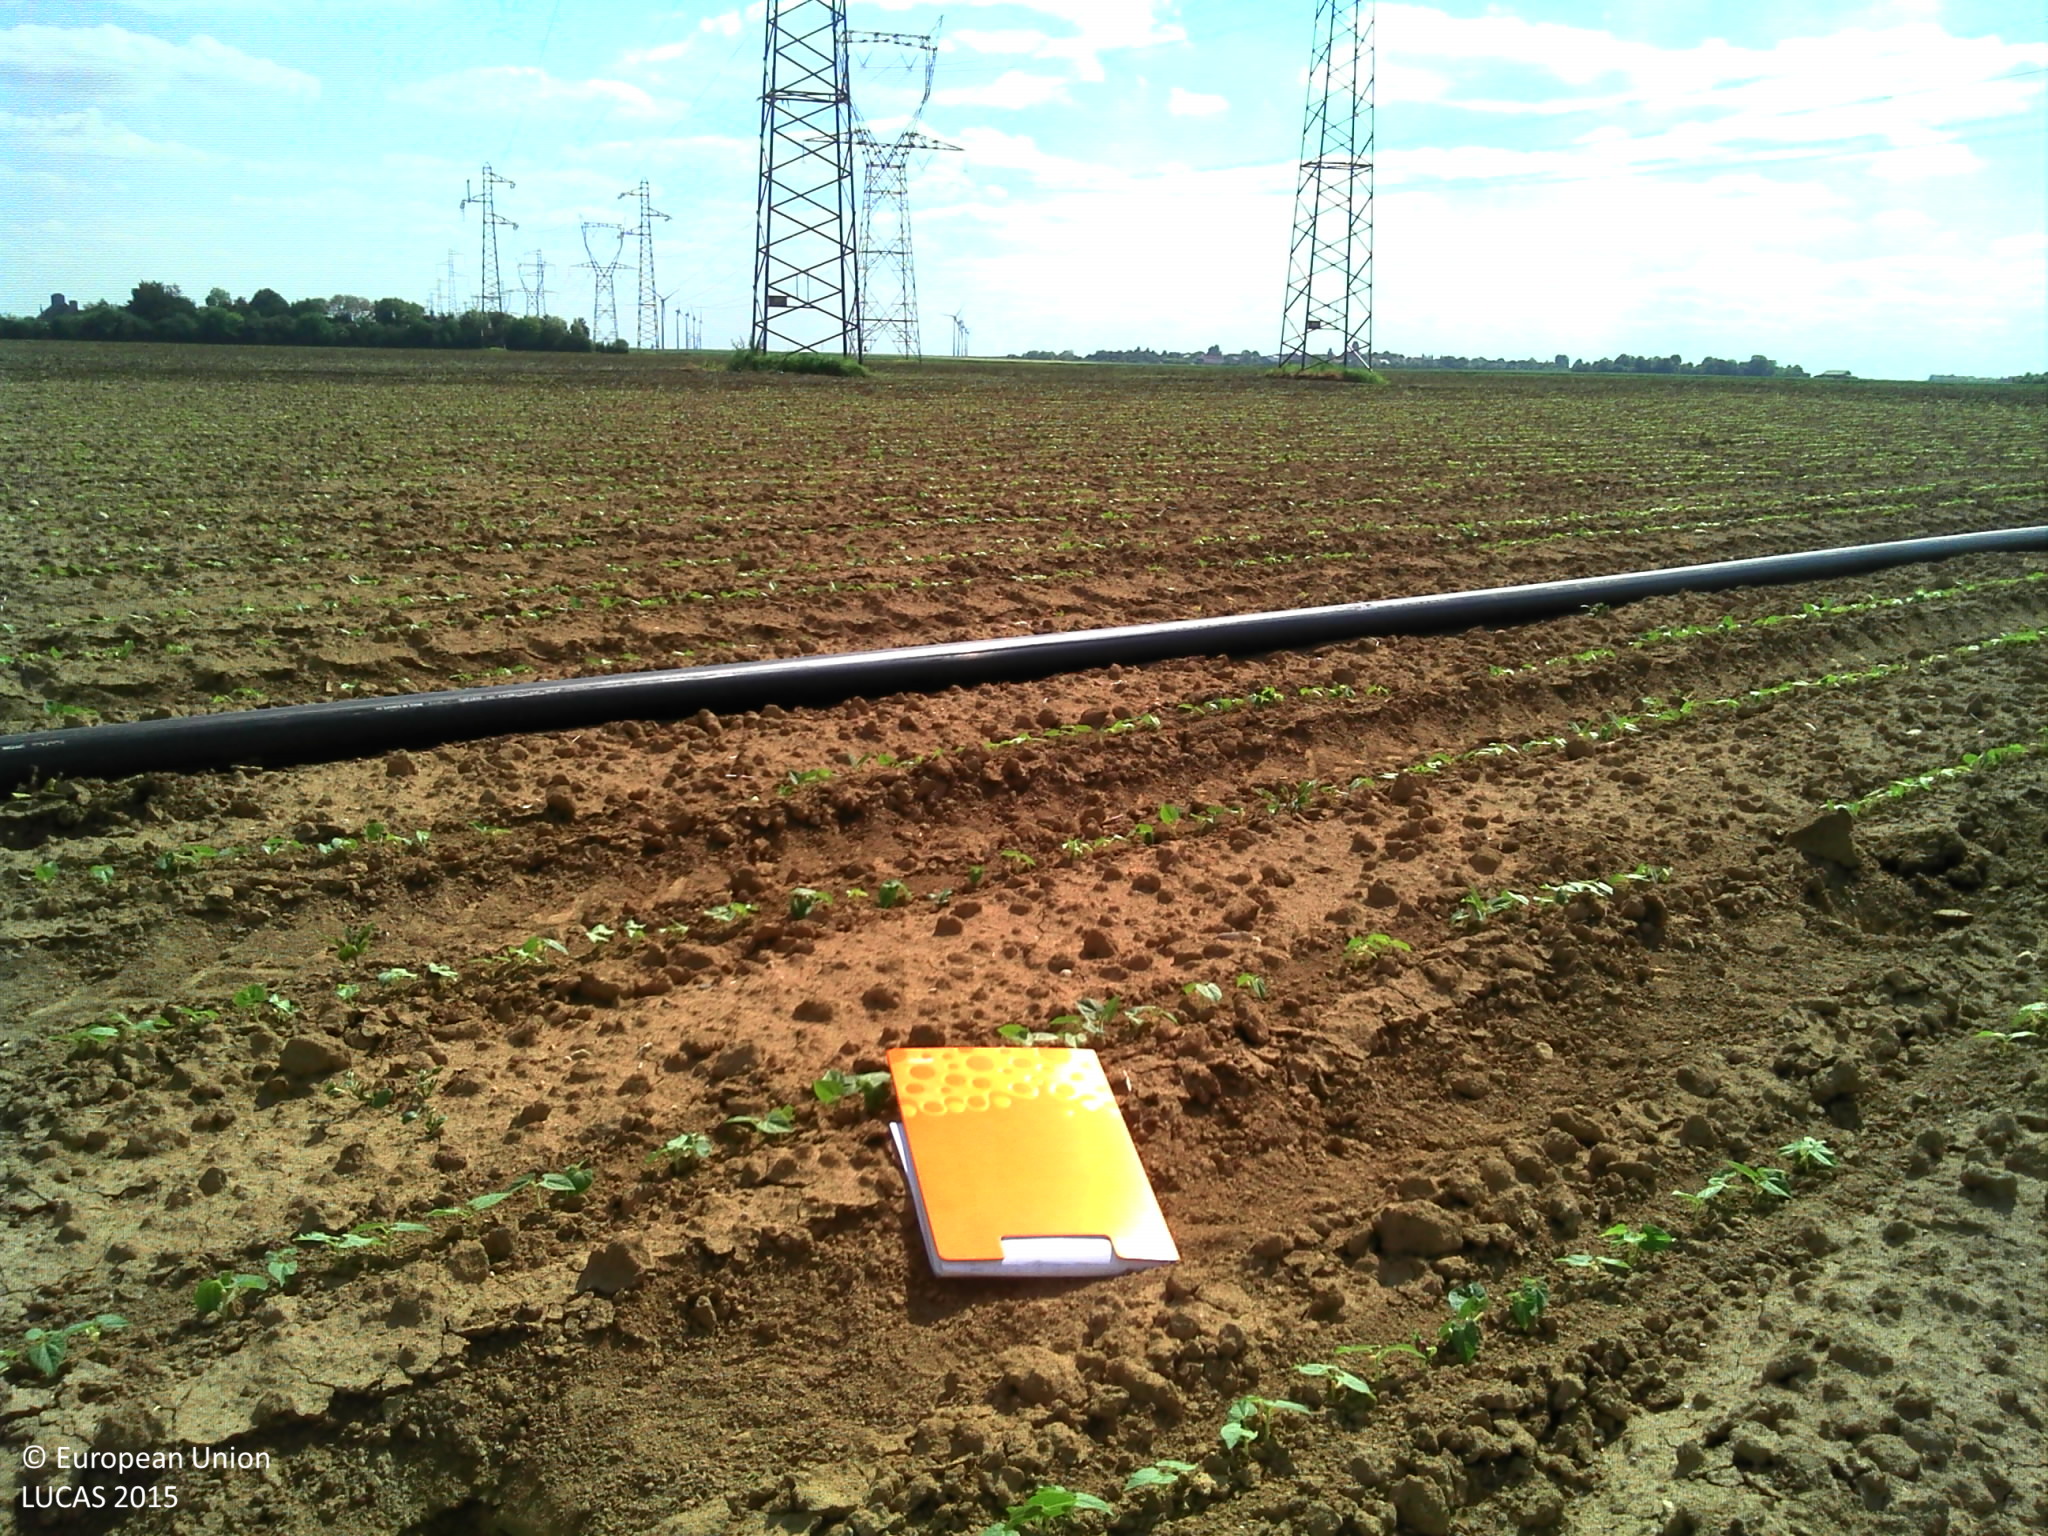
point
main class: Cropland
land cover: Dry pulses
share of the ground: 25 - 50 %
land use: Agriculture (excluding fallow land and kitchen gardens)
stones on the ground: < 10 %
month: May
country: FR
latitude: 48.2917
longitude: 1.9670
